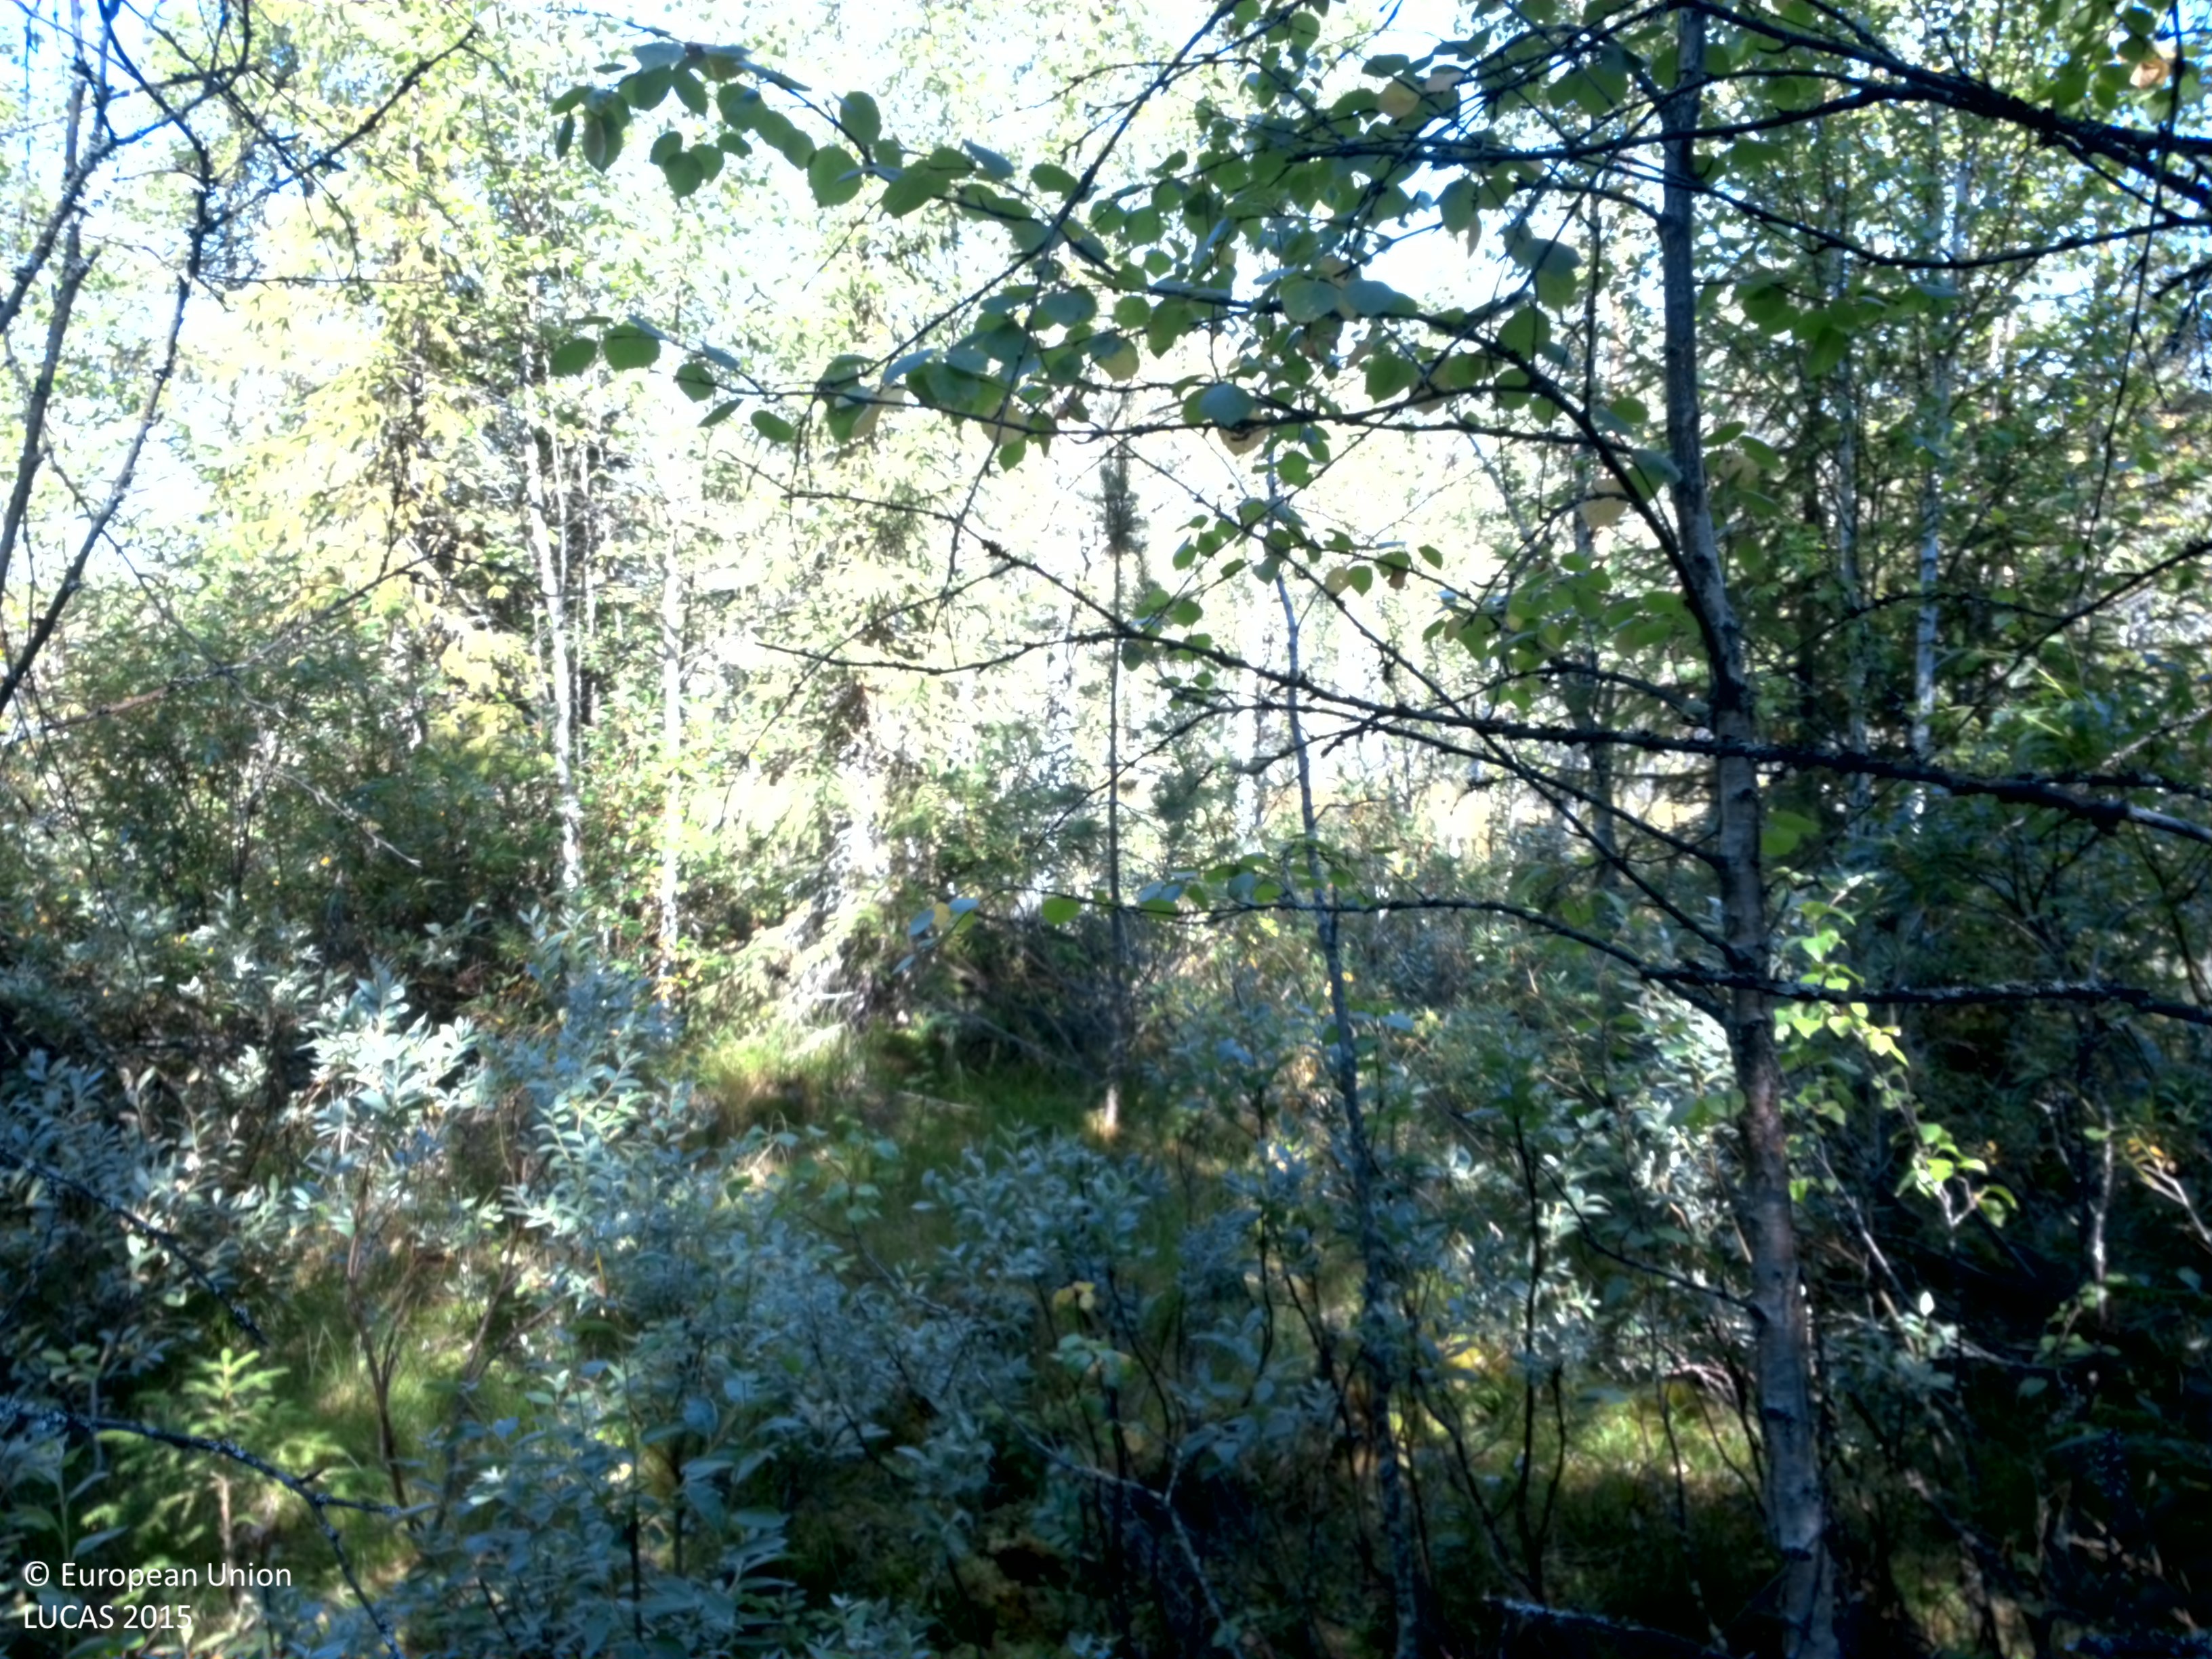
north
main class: Woodland
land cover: Broadleaved woodland
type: non-riverine alder, birch or aspen forest
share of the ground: 25 - 50 %
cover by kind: shrubs 40 %, broadleaved forest trees 35 %, coniferous forest trees 10 %, lichens and mosses 10 %, herbaceous plants 5 %
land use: Semi-natural and natural areas not in use
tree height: > 5 m
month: August
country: SE
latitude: 64.6578
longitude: 16.6463
